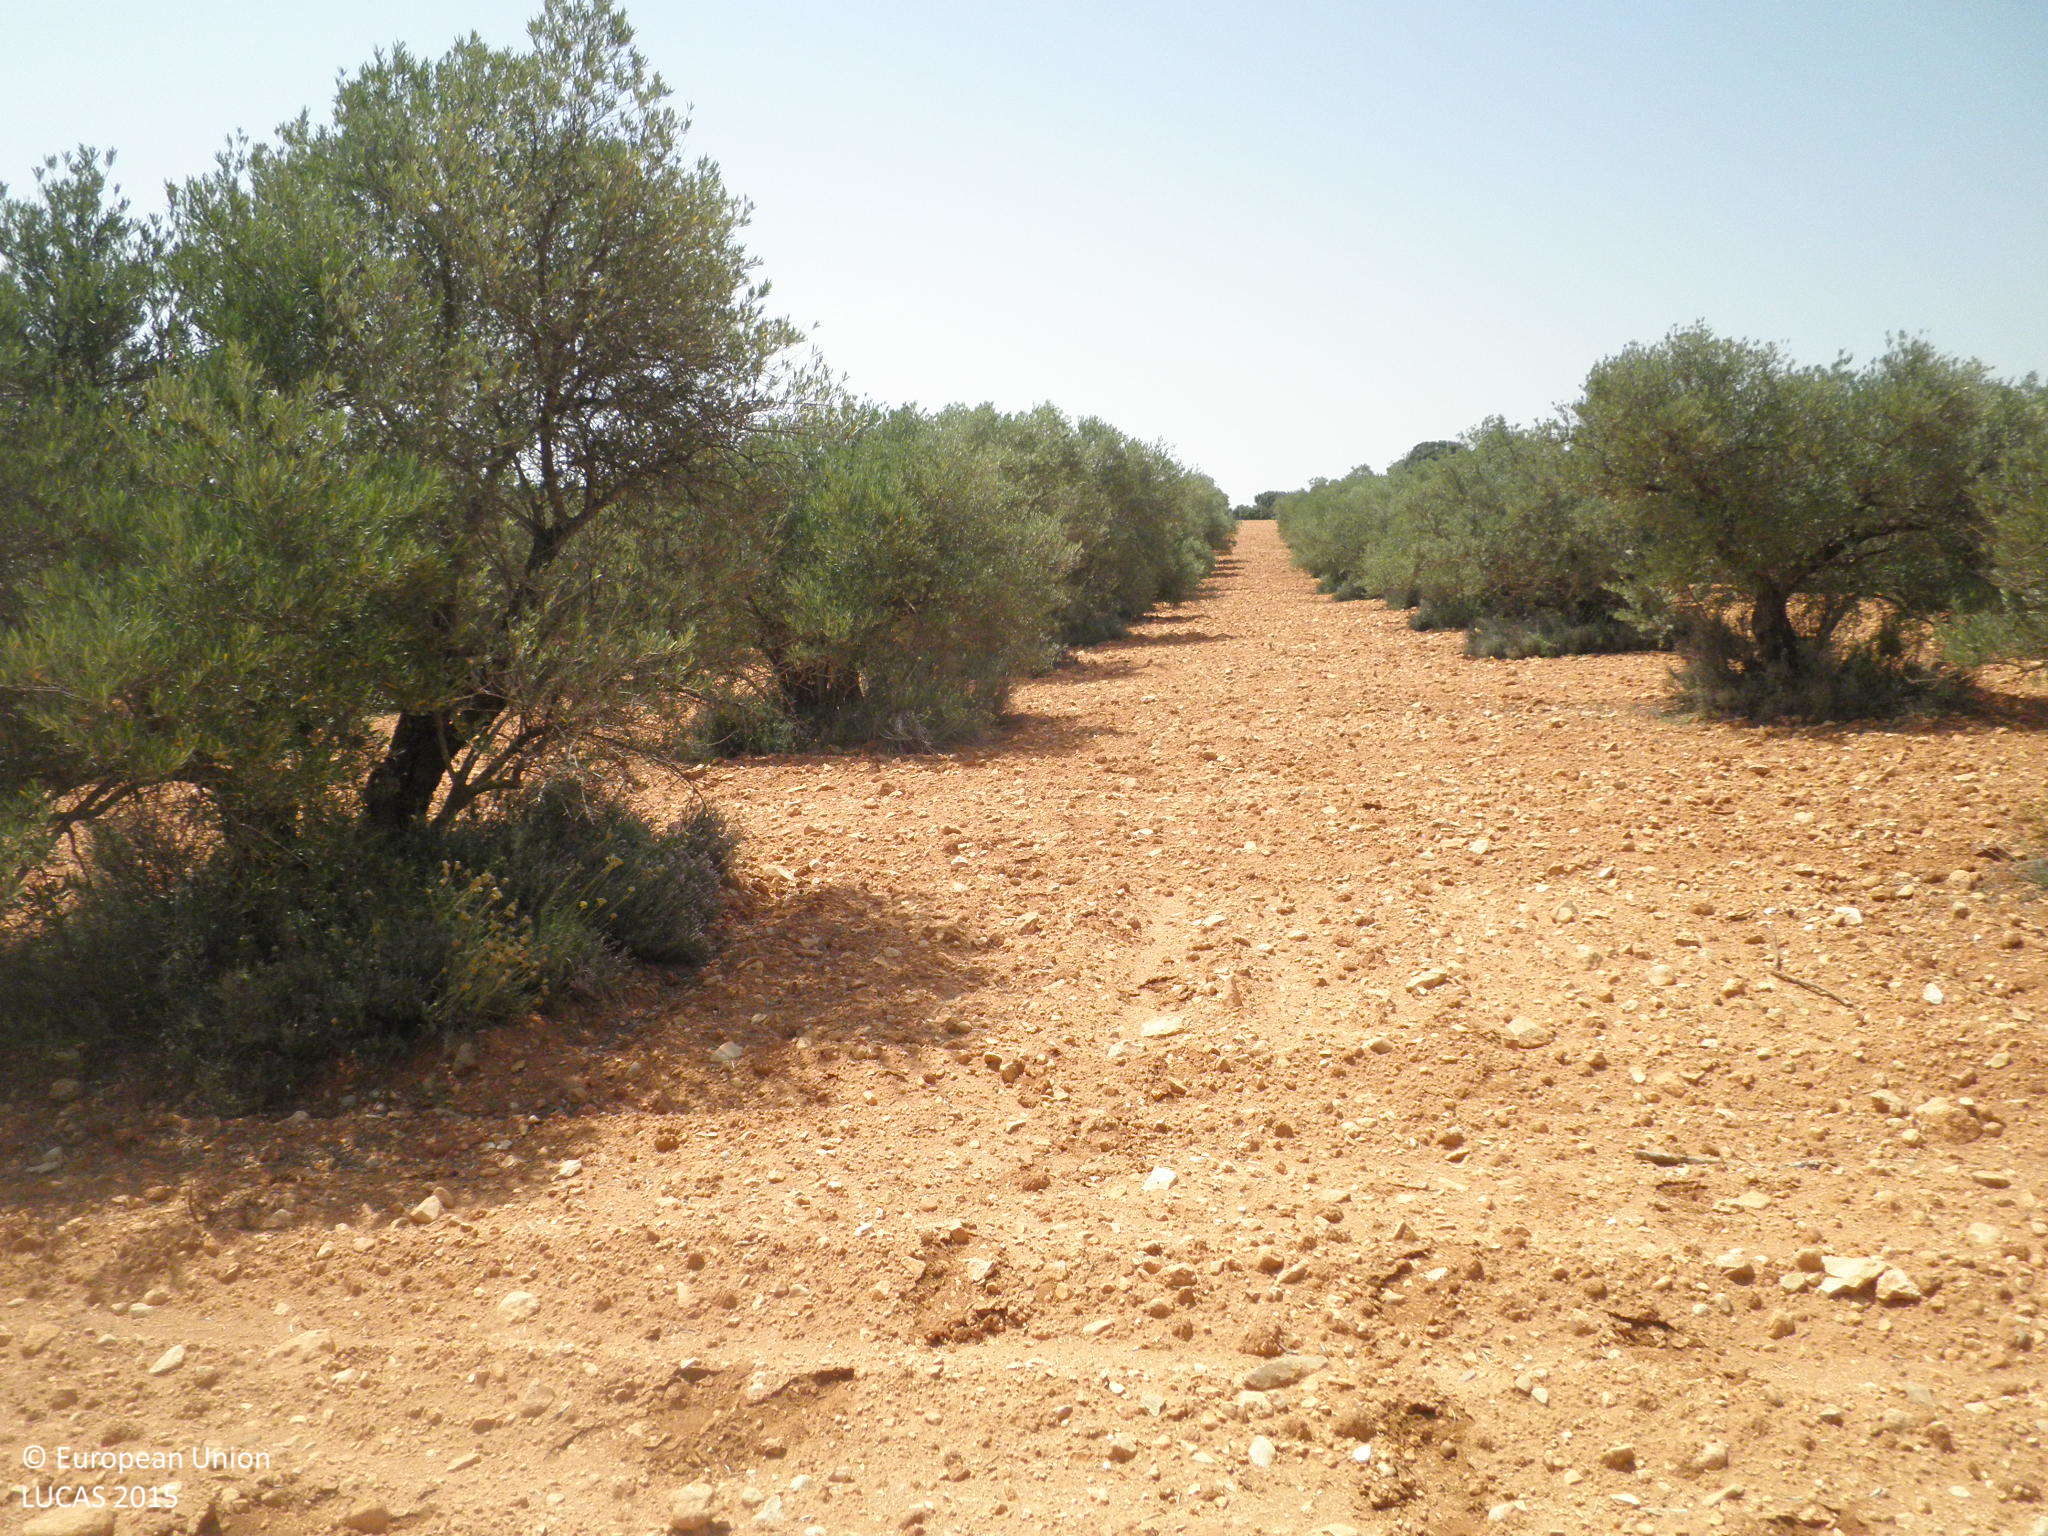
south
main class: Cropland
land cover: Olive groves
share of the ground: 10 - 25 %
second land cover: Other bare soil
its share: > 75 %
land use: Agriculture (excluding fallow land and kitchen gardens)
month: July
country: ES
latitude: 39.5945
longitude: -2.6257
